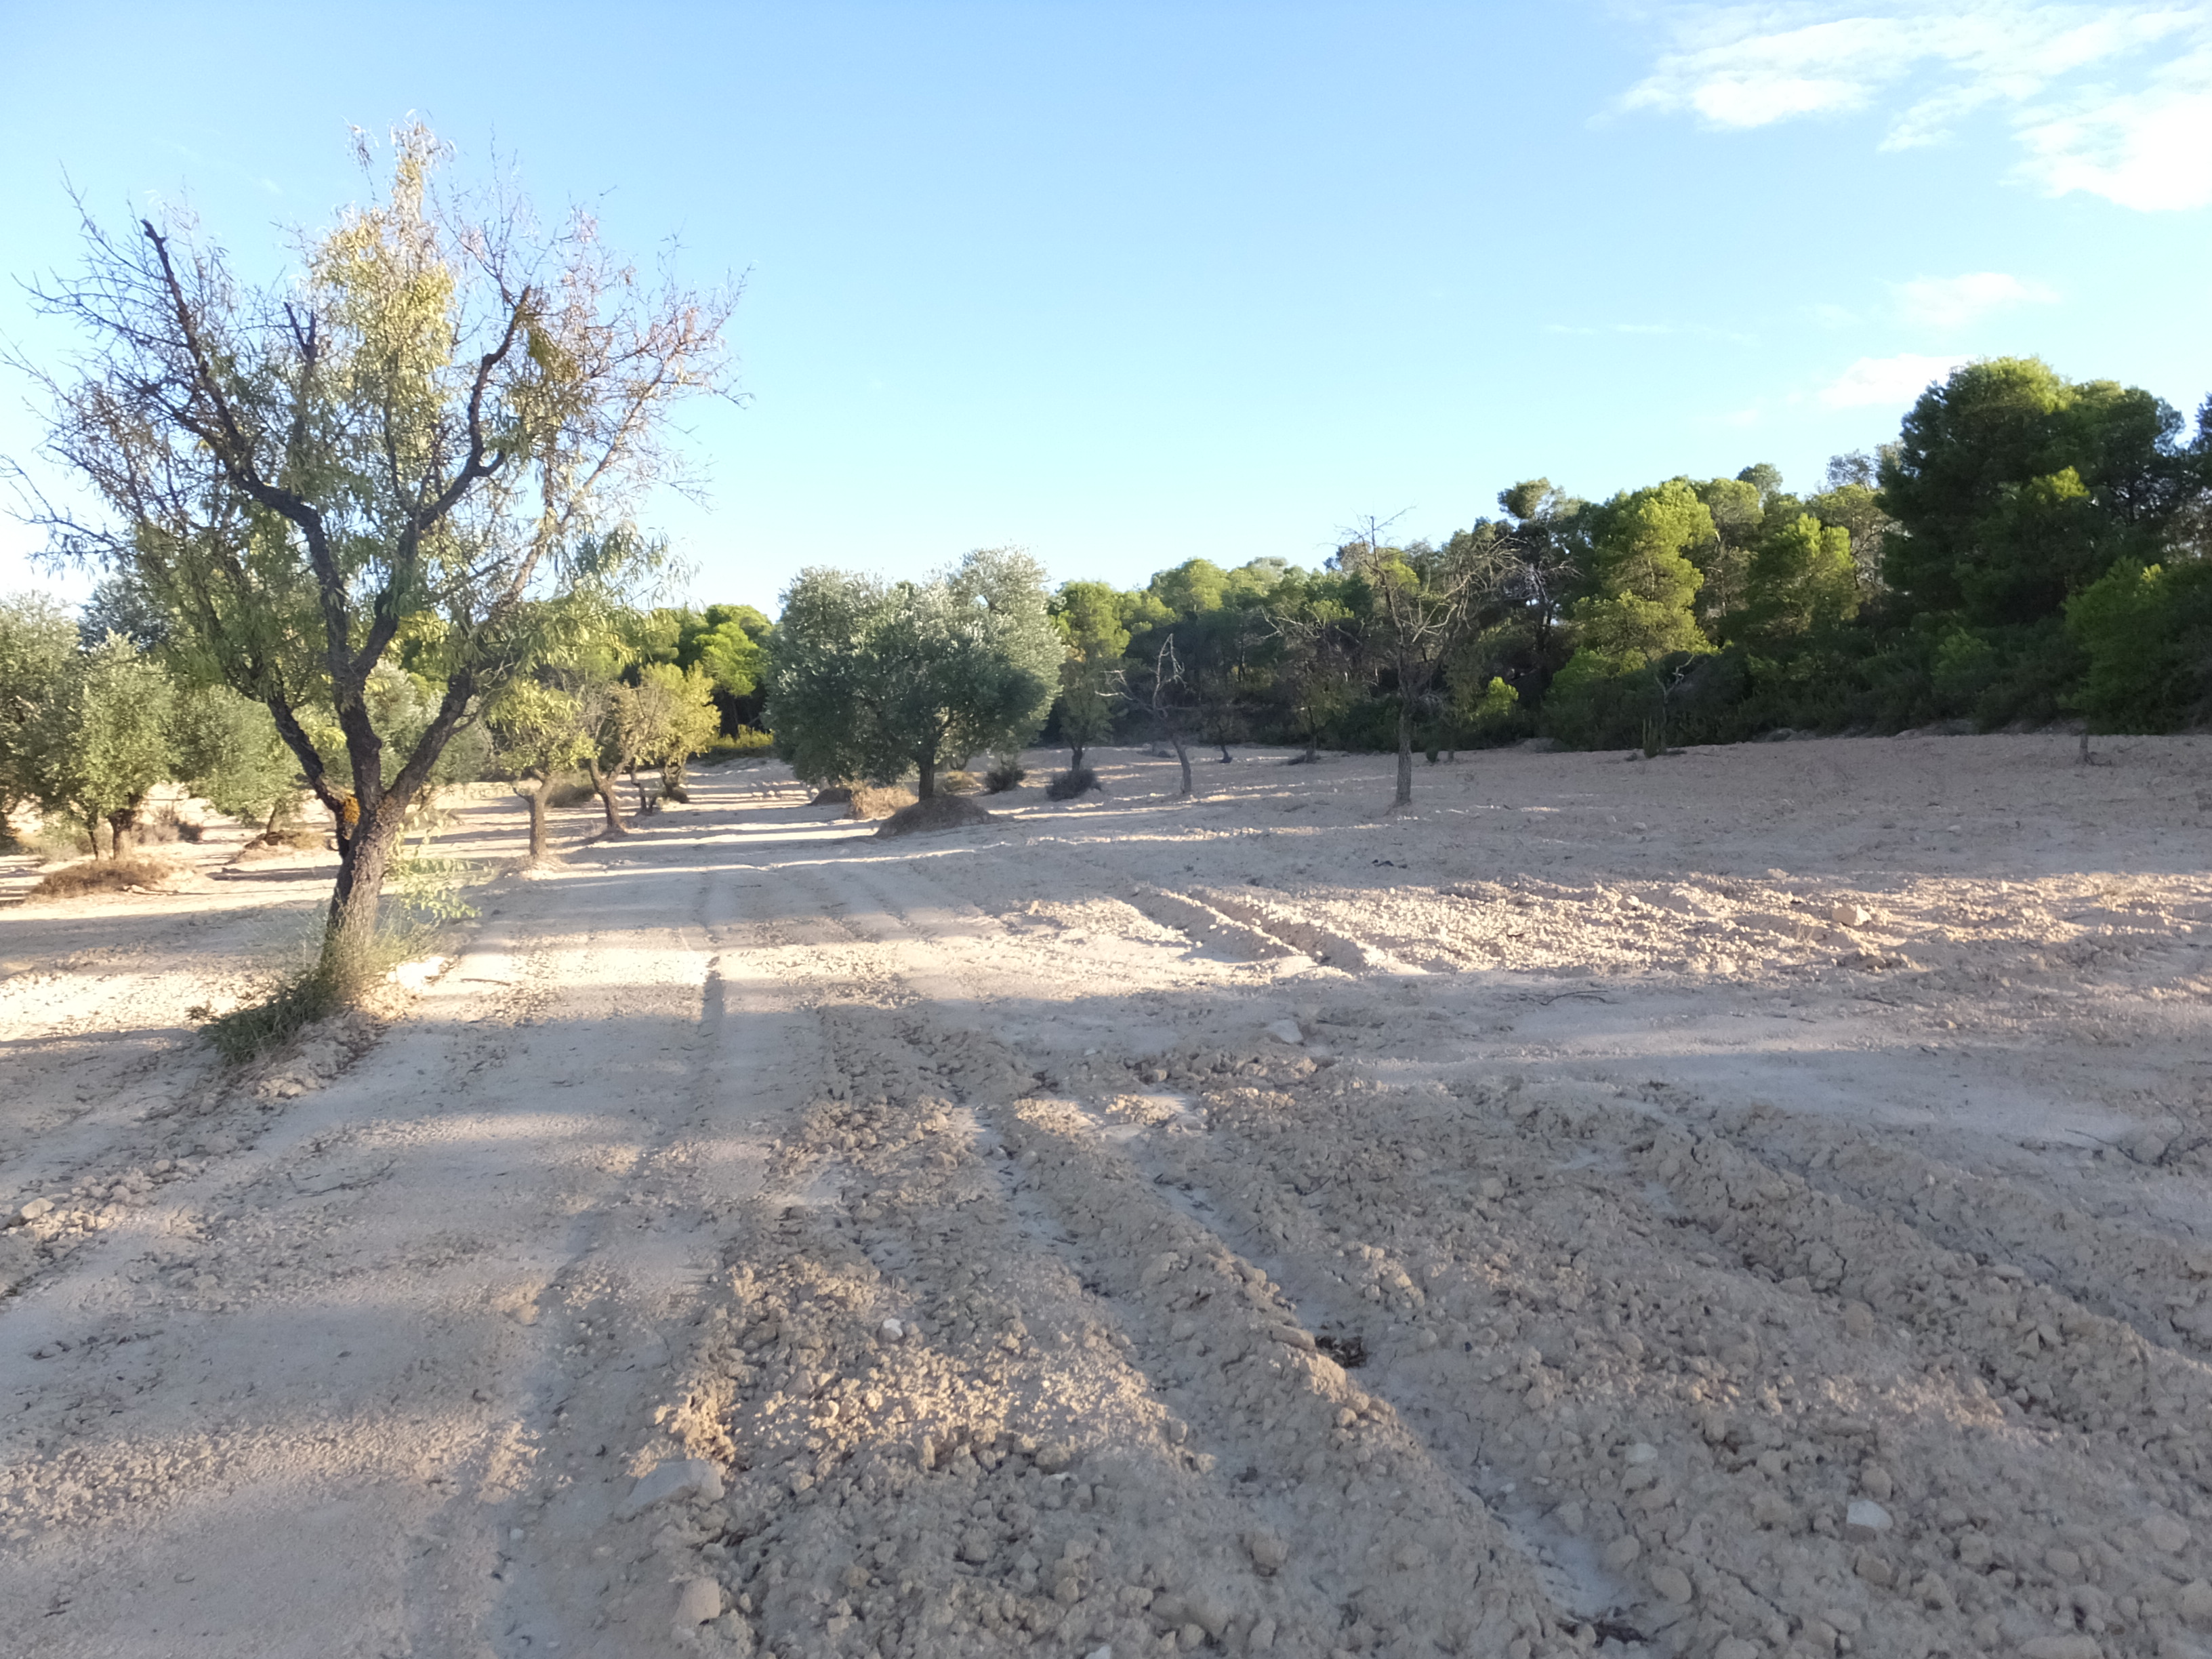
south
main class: Cropland
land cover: Nuts trees
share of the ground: 50 - 75 %
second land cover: Olive groves
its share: 25 - 50 %
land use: Agriculture (excluding fallow land and kitchen gardens)
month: August
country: ES
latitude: 41.2672
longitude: 0.1883
